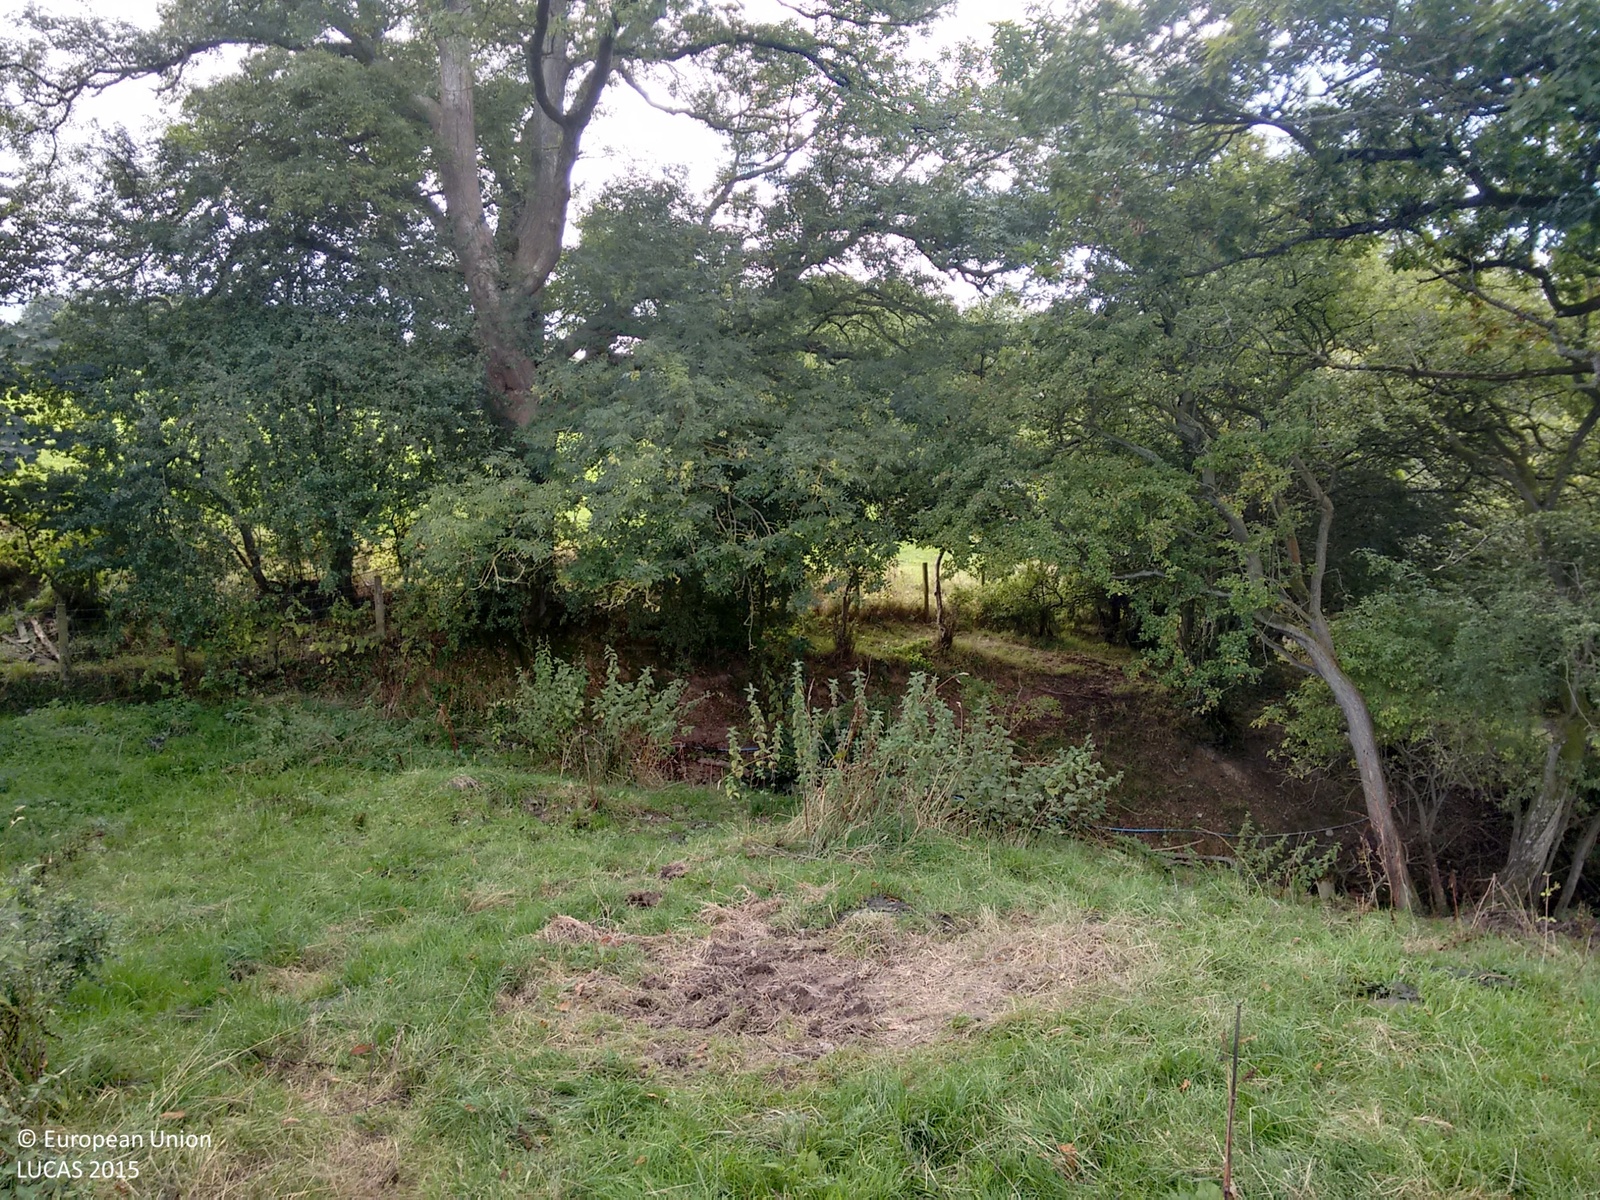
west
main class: Grassland
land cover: Grassland without tree/shrub cover
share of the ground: > 75 %
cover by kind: herbaceous plants 100 %
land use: Agriculture (excluding fallow land and kitchen gardens)
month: September
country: GB
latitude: 52.6448
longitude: -3.3082
